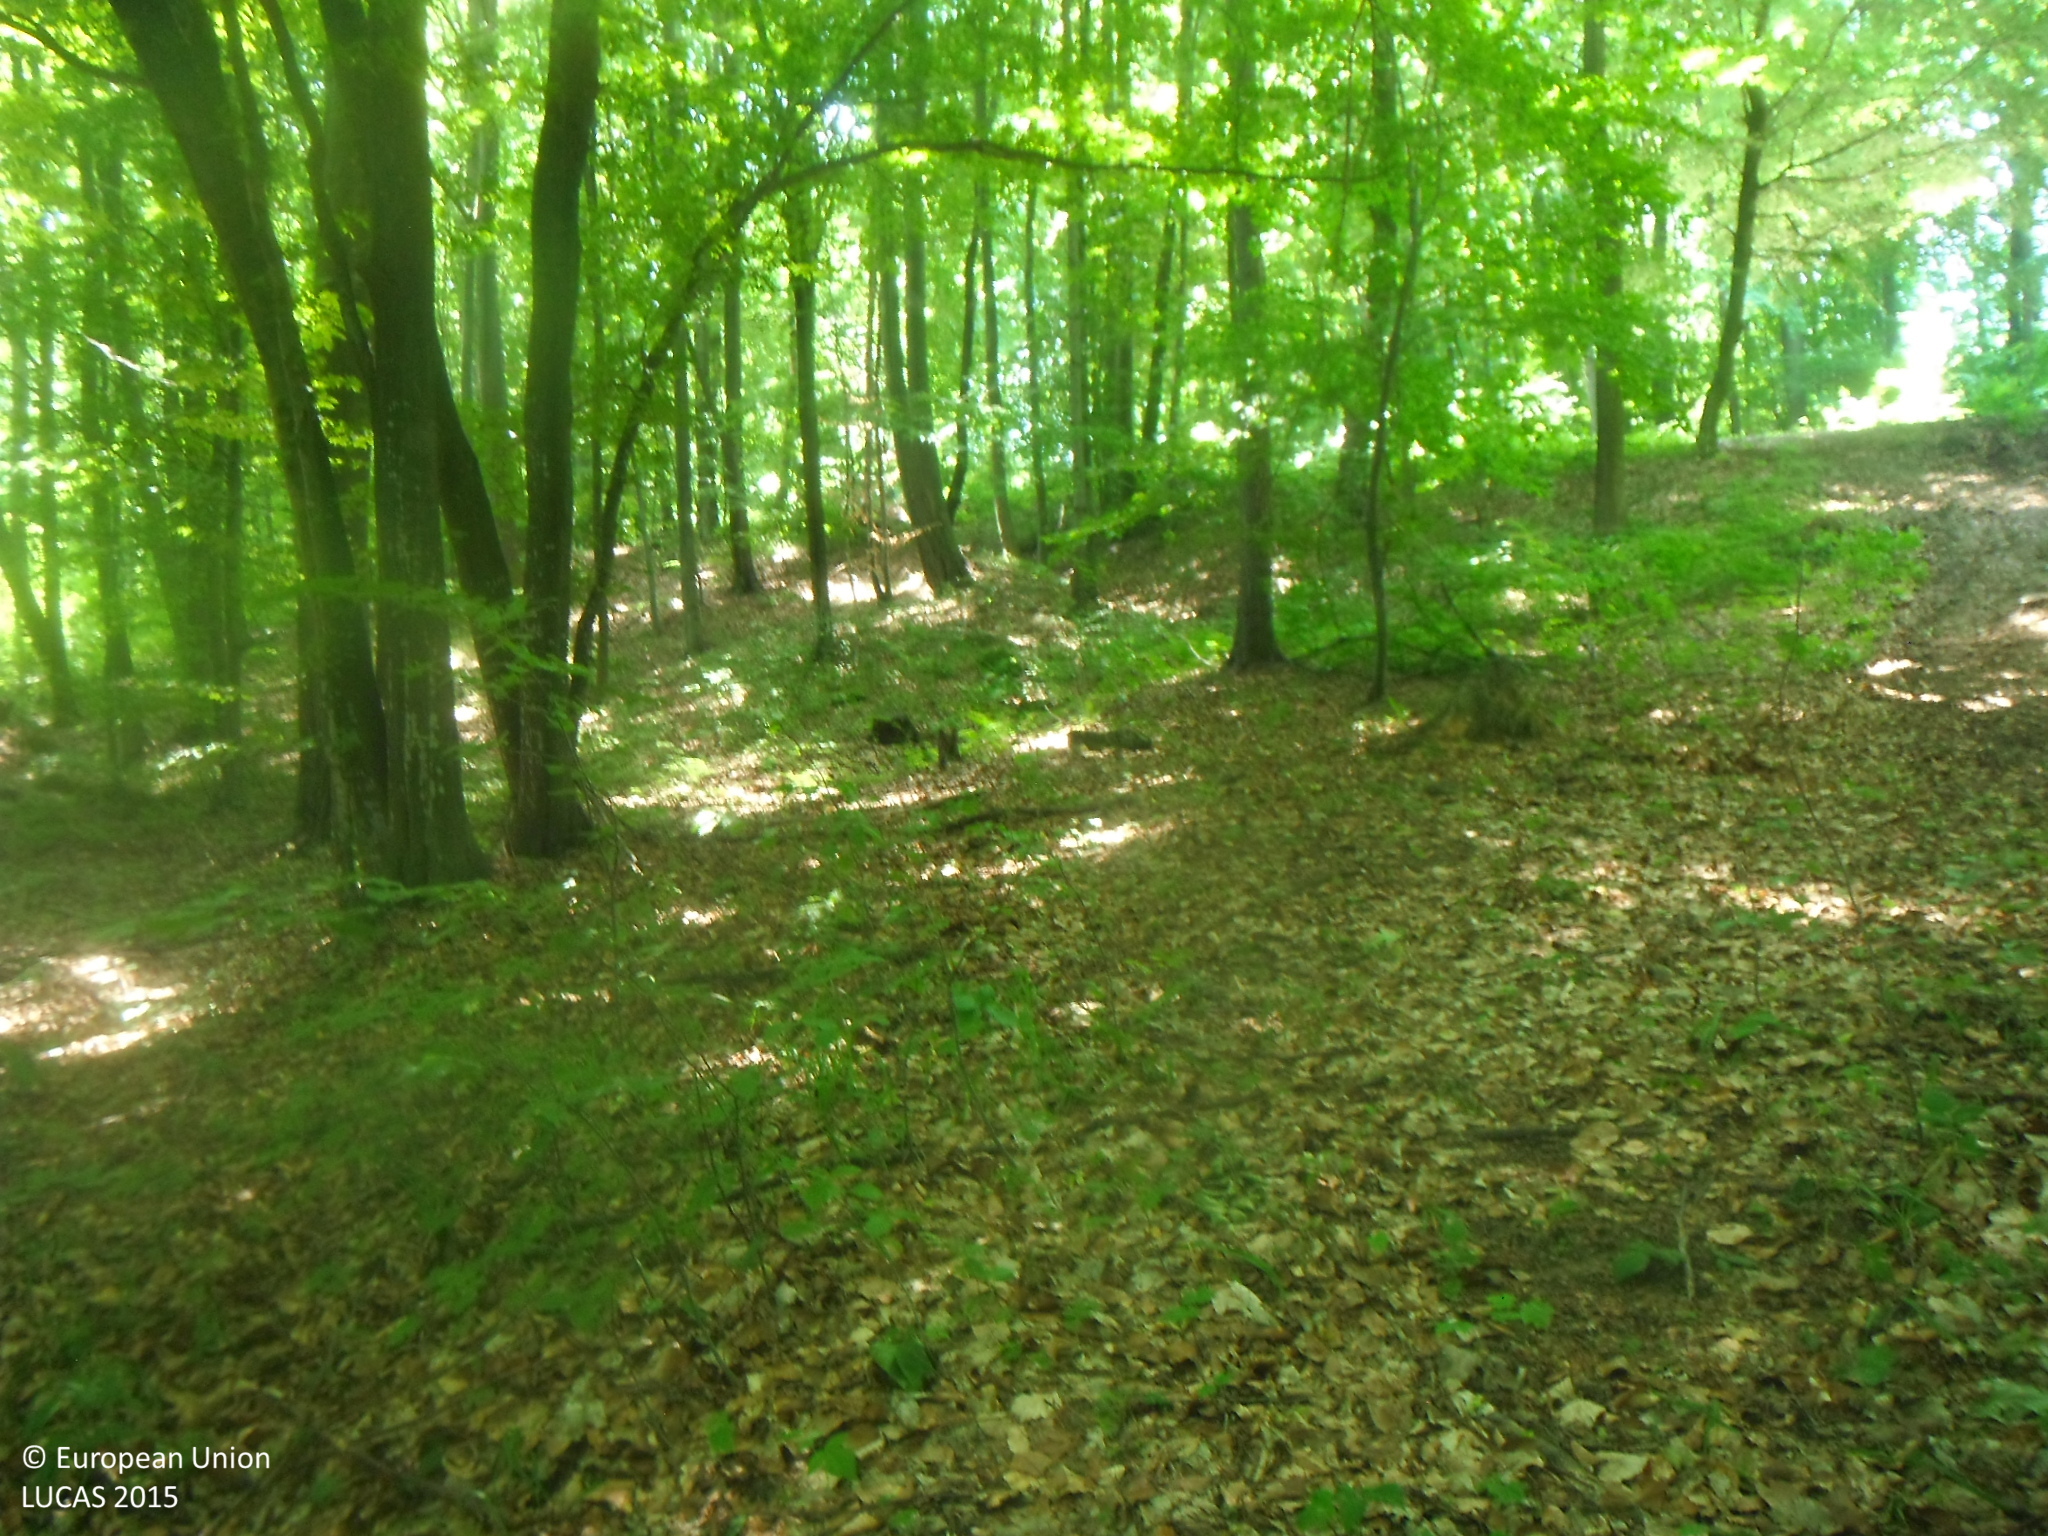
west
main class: Woodland
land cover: Broadleaved woodland
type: beech forest
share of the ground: > 75 %
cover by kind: broadleaved forest trees 100 %
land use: Forestry
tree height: > 5 m
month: June
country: SK
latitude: 48.9484
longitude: 21.4770
